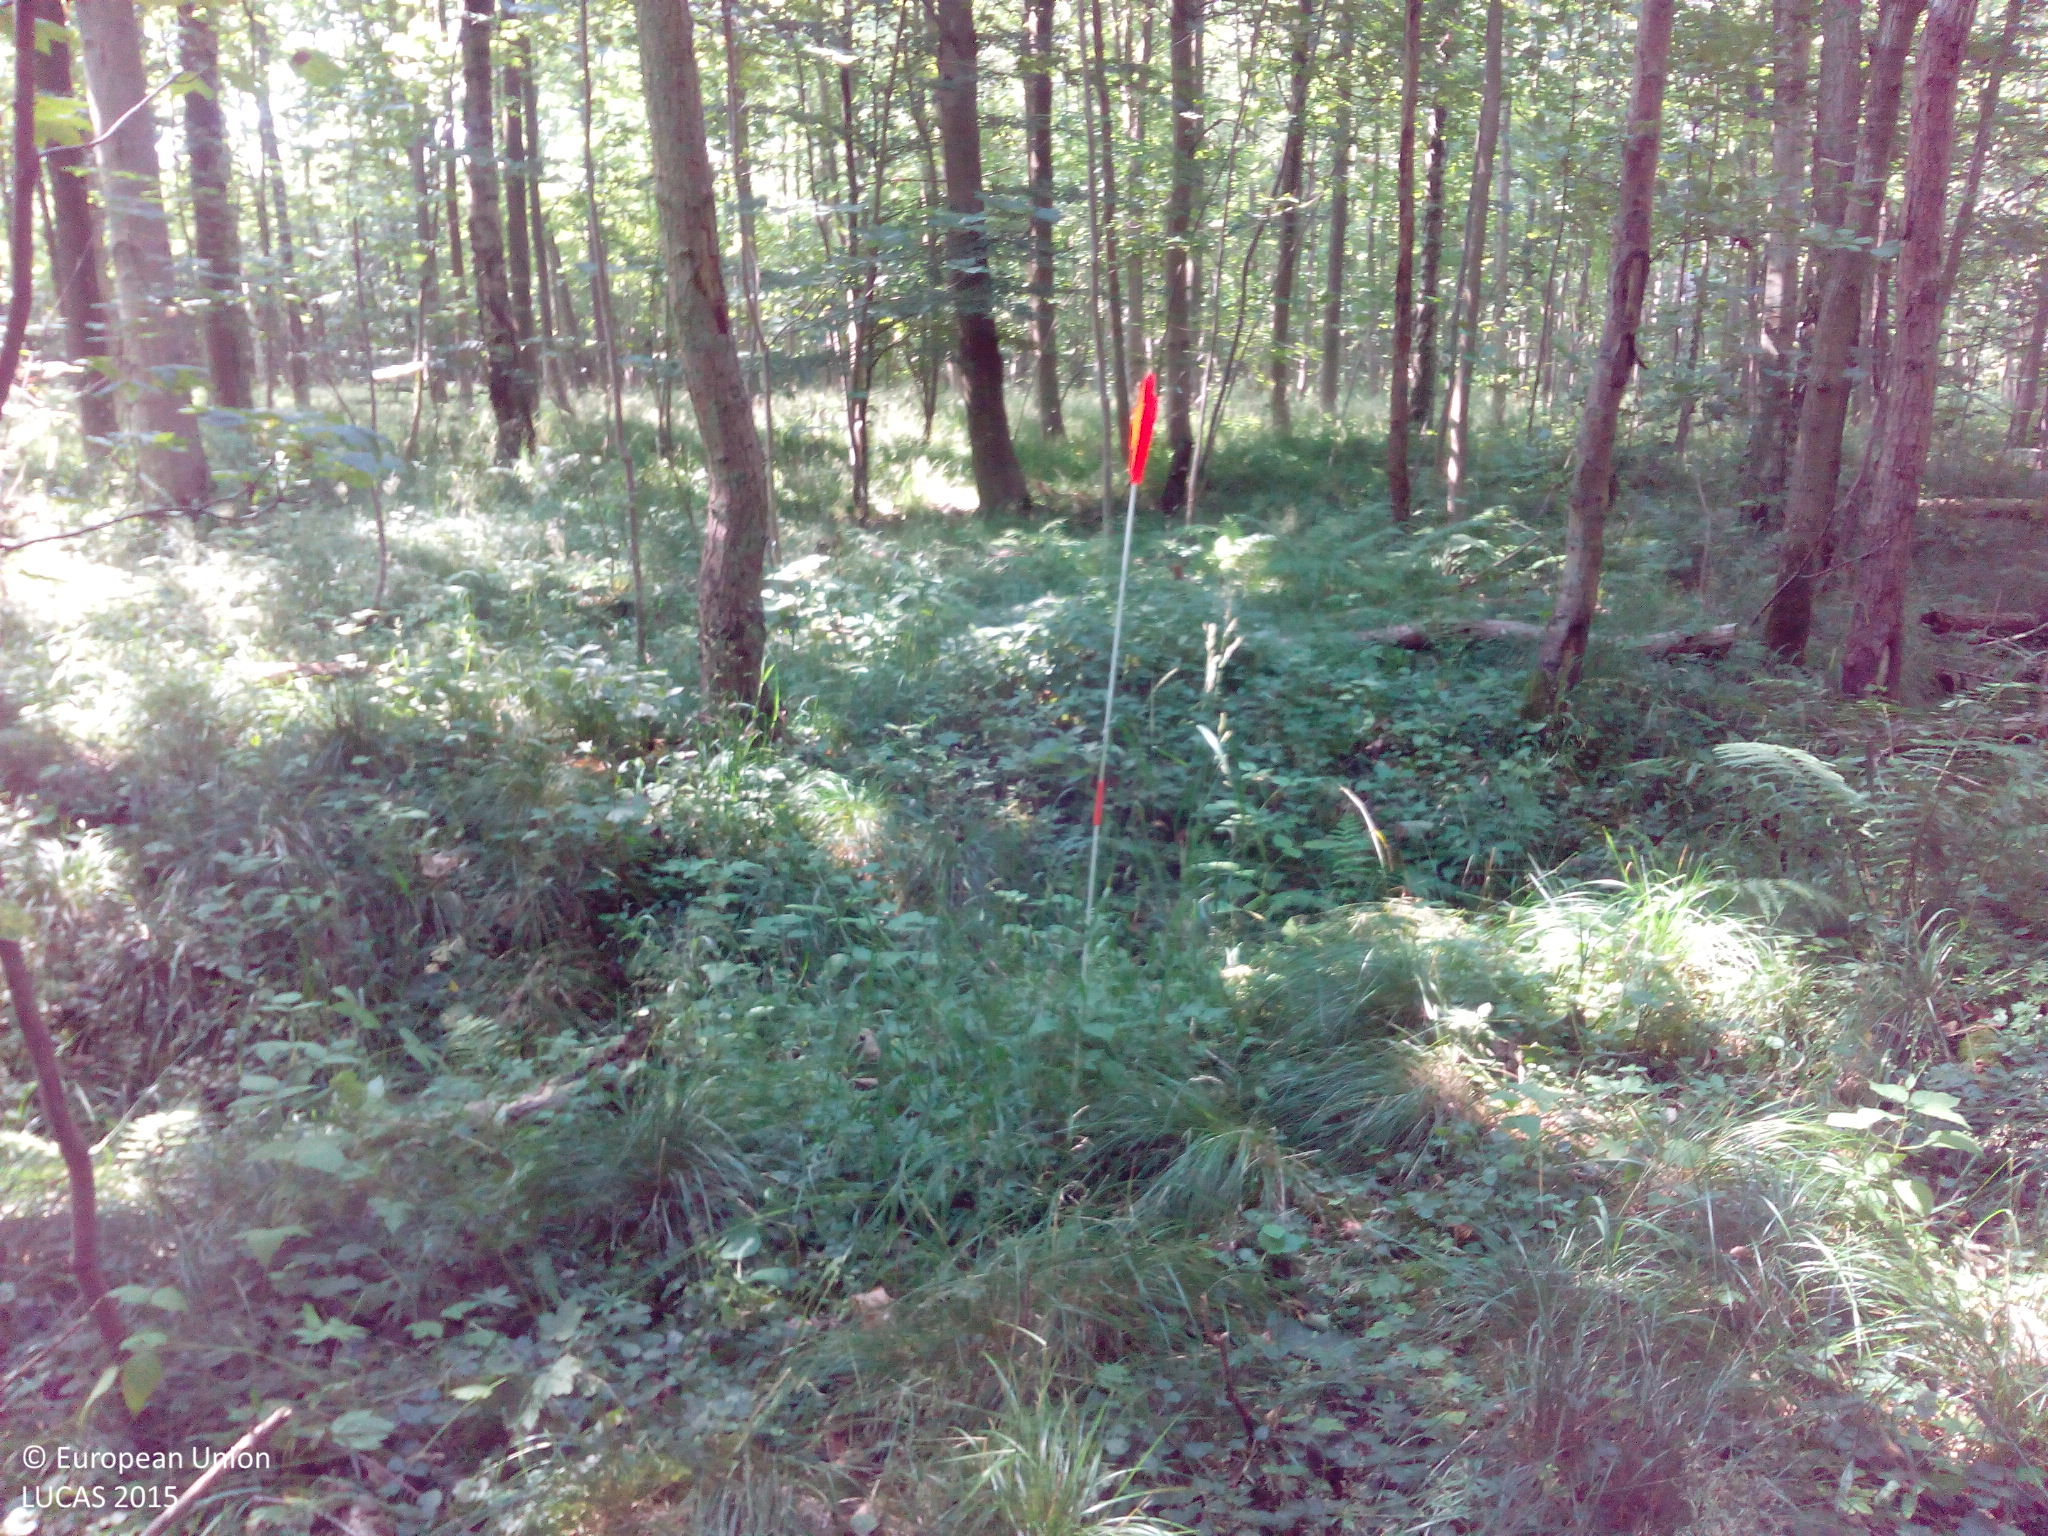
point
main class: Woodland
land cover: Broadleaved woodland
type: beech forest
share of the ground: > 75 %
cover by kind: broadleaved forest trees 100 %
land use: Forestry
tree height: > 5 m
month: August
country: DK
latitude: 55.4508
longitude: 12.1328
